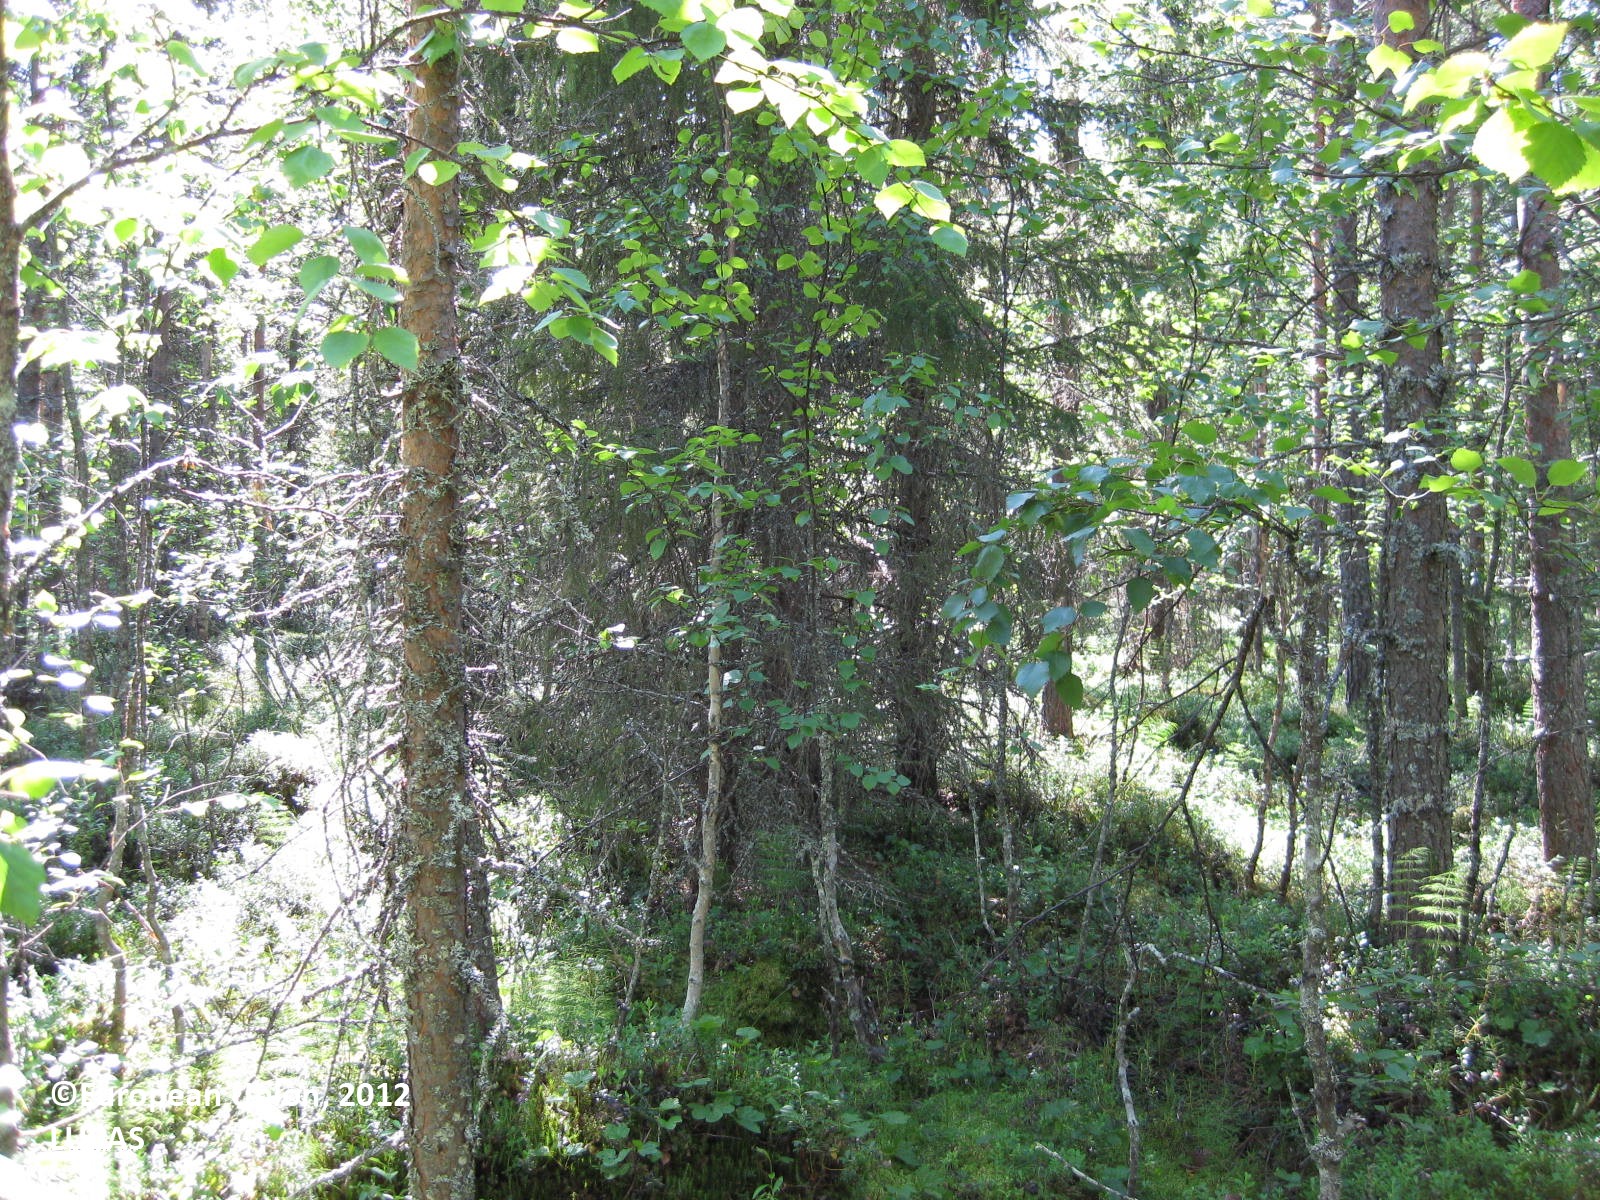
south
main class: Woodland
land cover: Pine dominated mixed woodland
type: boreal forest
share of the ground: > 75 %
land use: Forestry
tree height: > 5 m
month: July
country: FI
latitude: 65.6121
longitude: 28.5000
